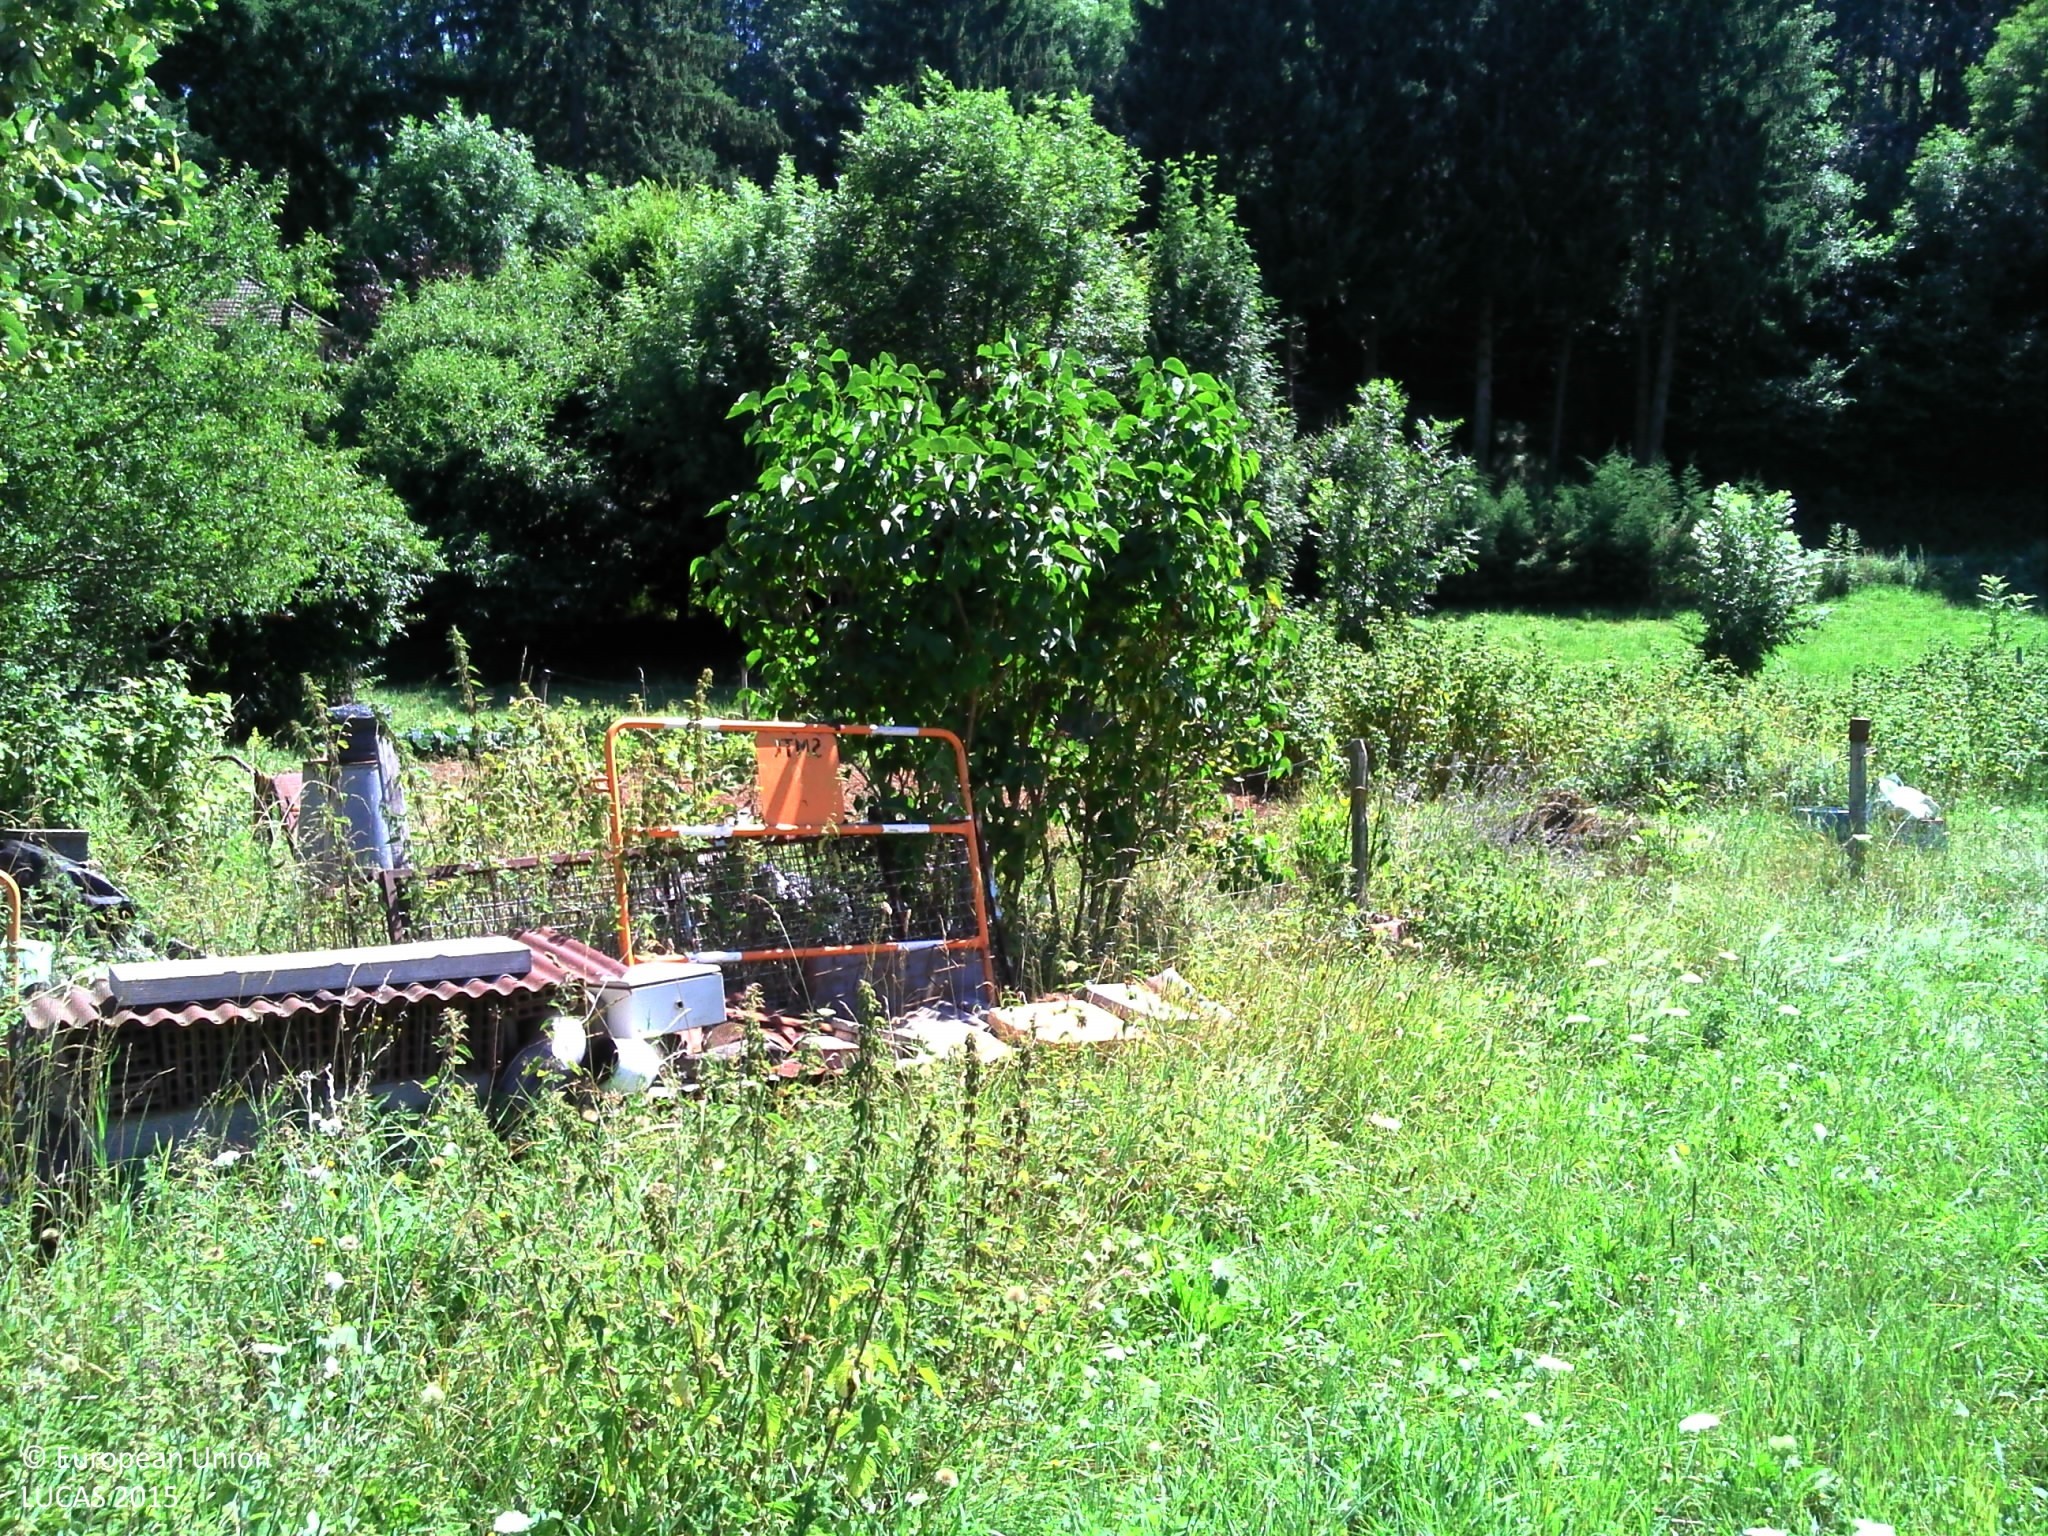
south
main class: Grassland
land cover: Grassland without tree/shrub cover
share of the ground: > 75 %
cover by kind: herbaceous plants 100 %
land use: Agriculture (excluding fallow land and kitchen gardens)
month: August
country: FR
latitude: 44.9819
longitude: 5.6559
